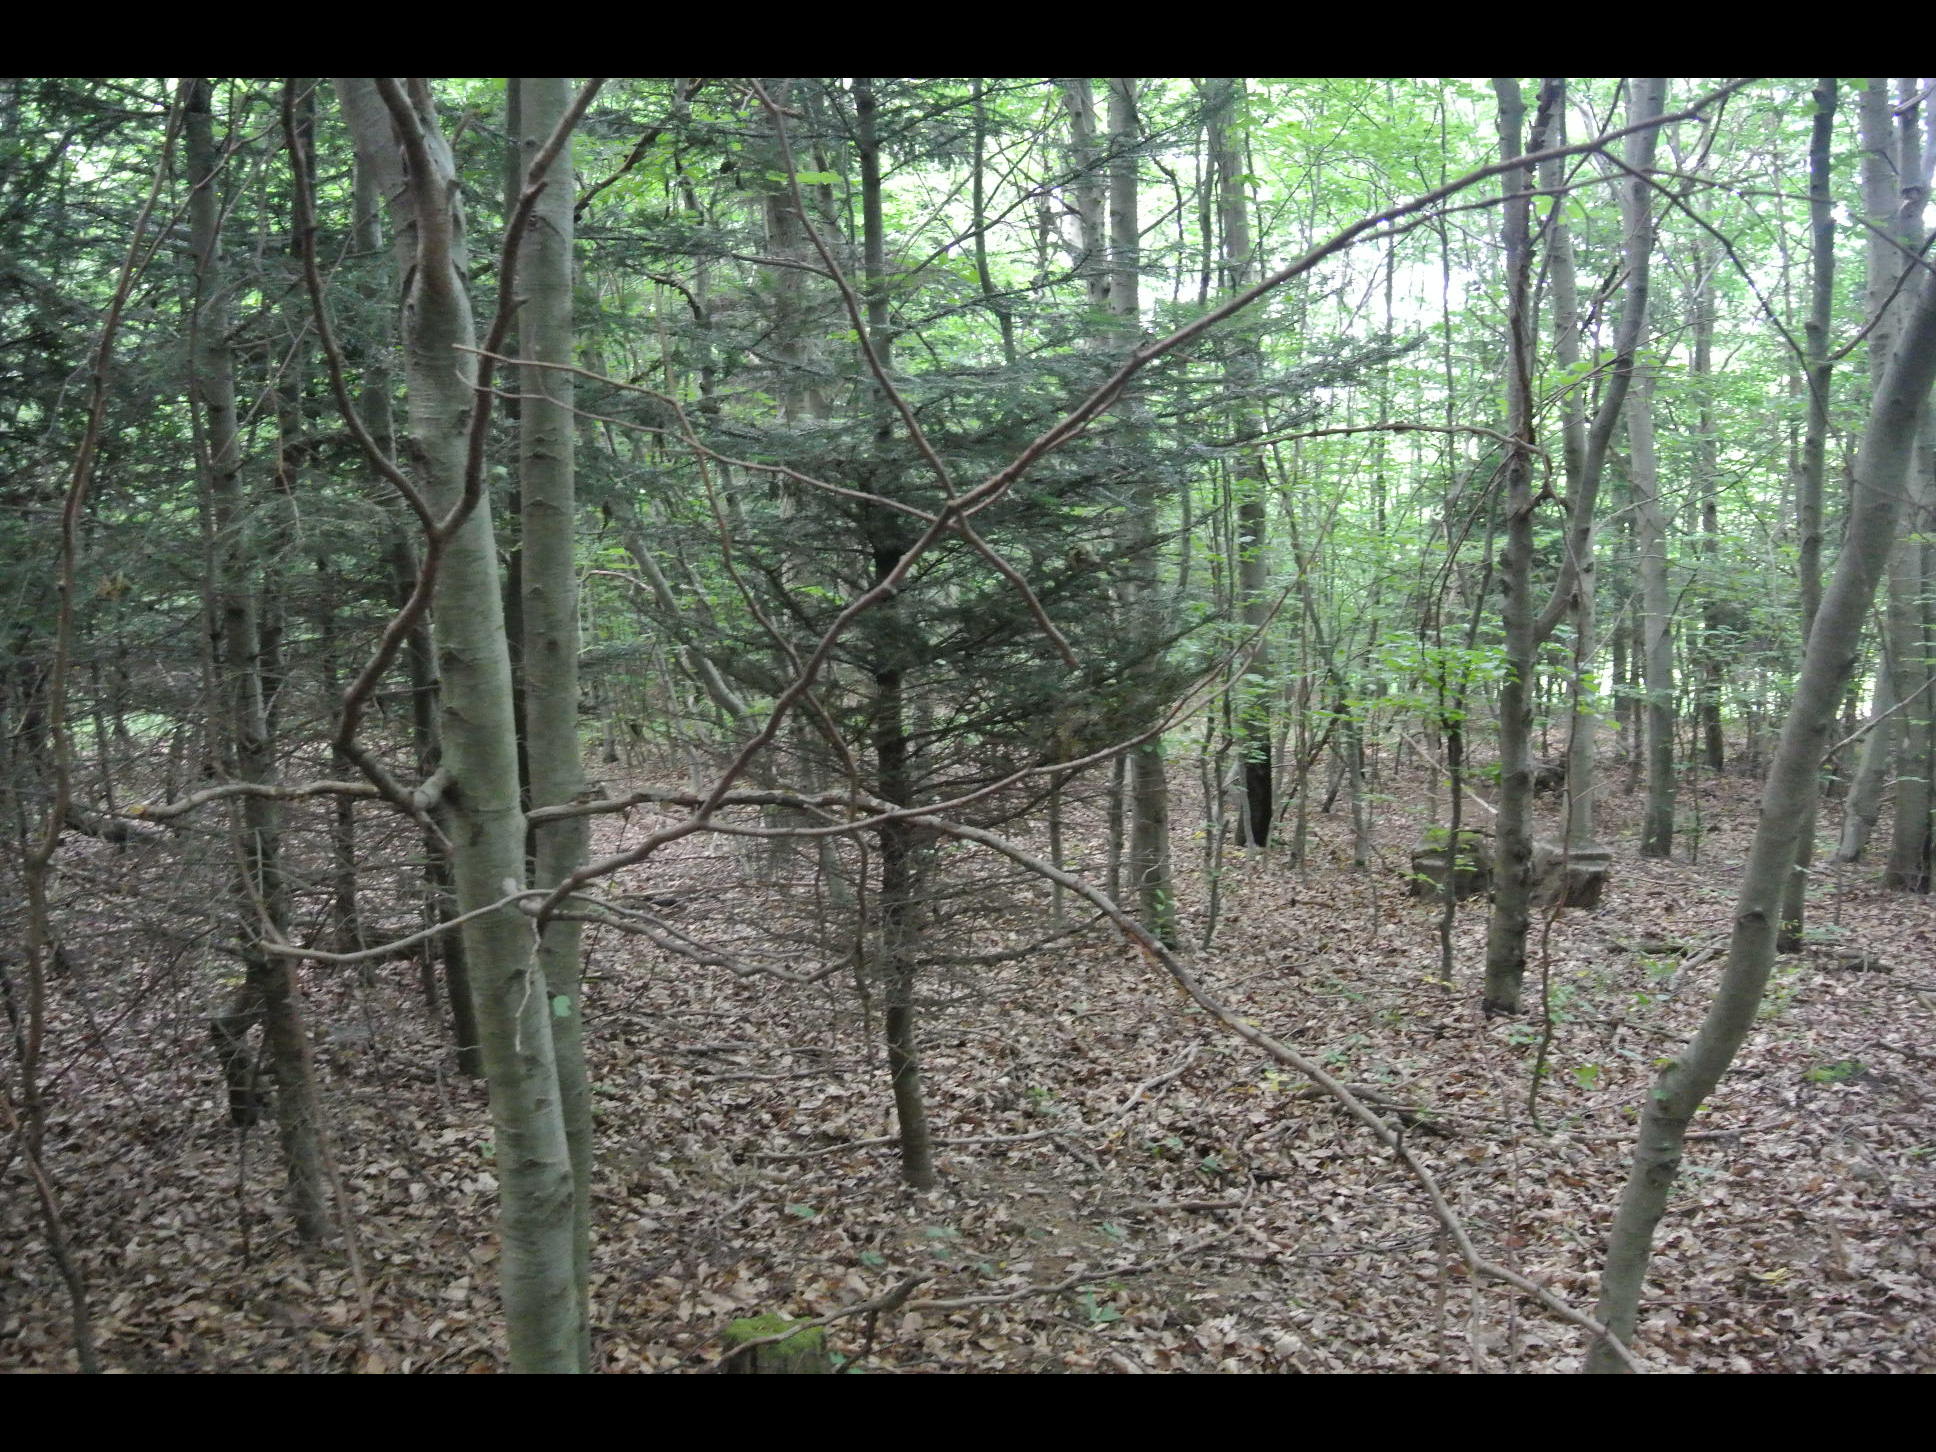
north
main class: Woodland
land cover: Spruce dominated mixed woodland
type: alpine coniferous forest
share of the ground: > 75 %
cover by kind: broadleaved forest trees 75 %, coniferous forest trees 25 %
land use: Forestry
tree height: > 5 m
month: June
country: AT
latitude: 48.0512
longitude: 16.1618
